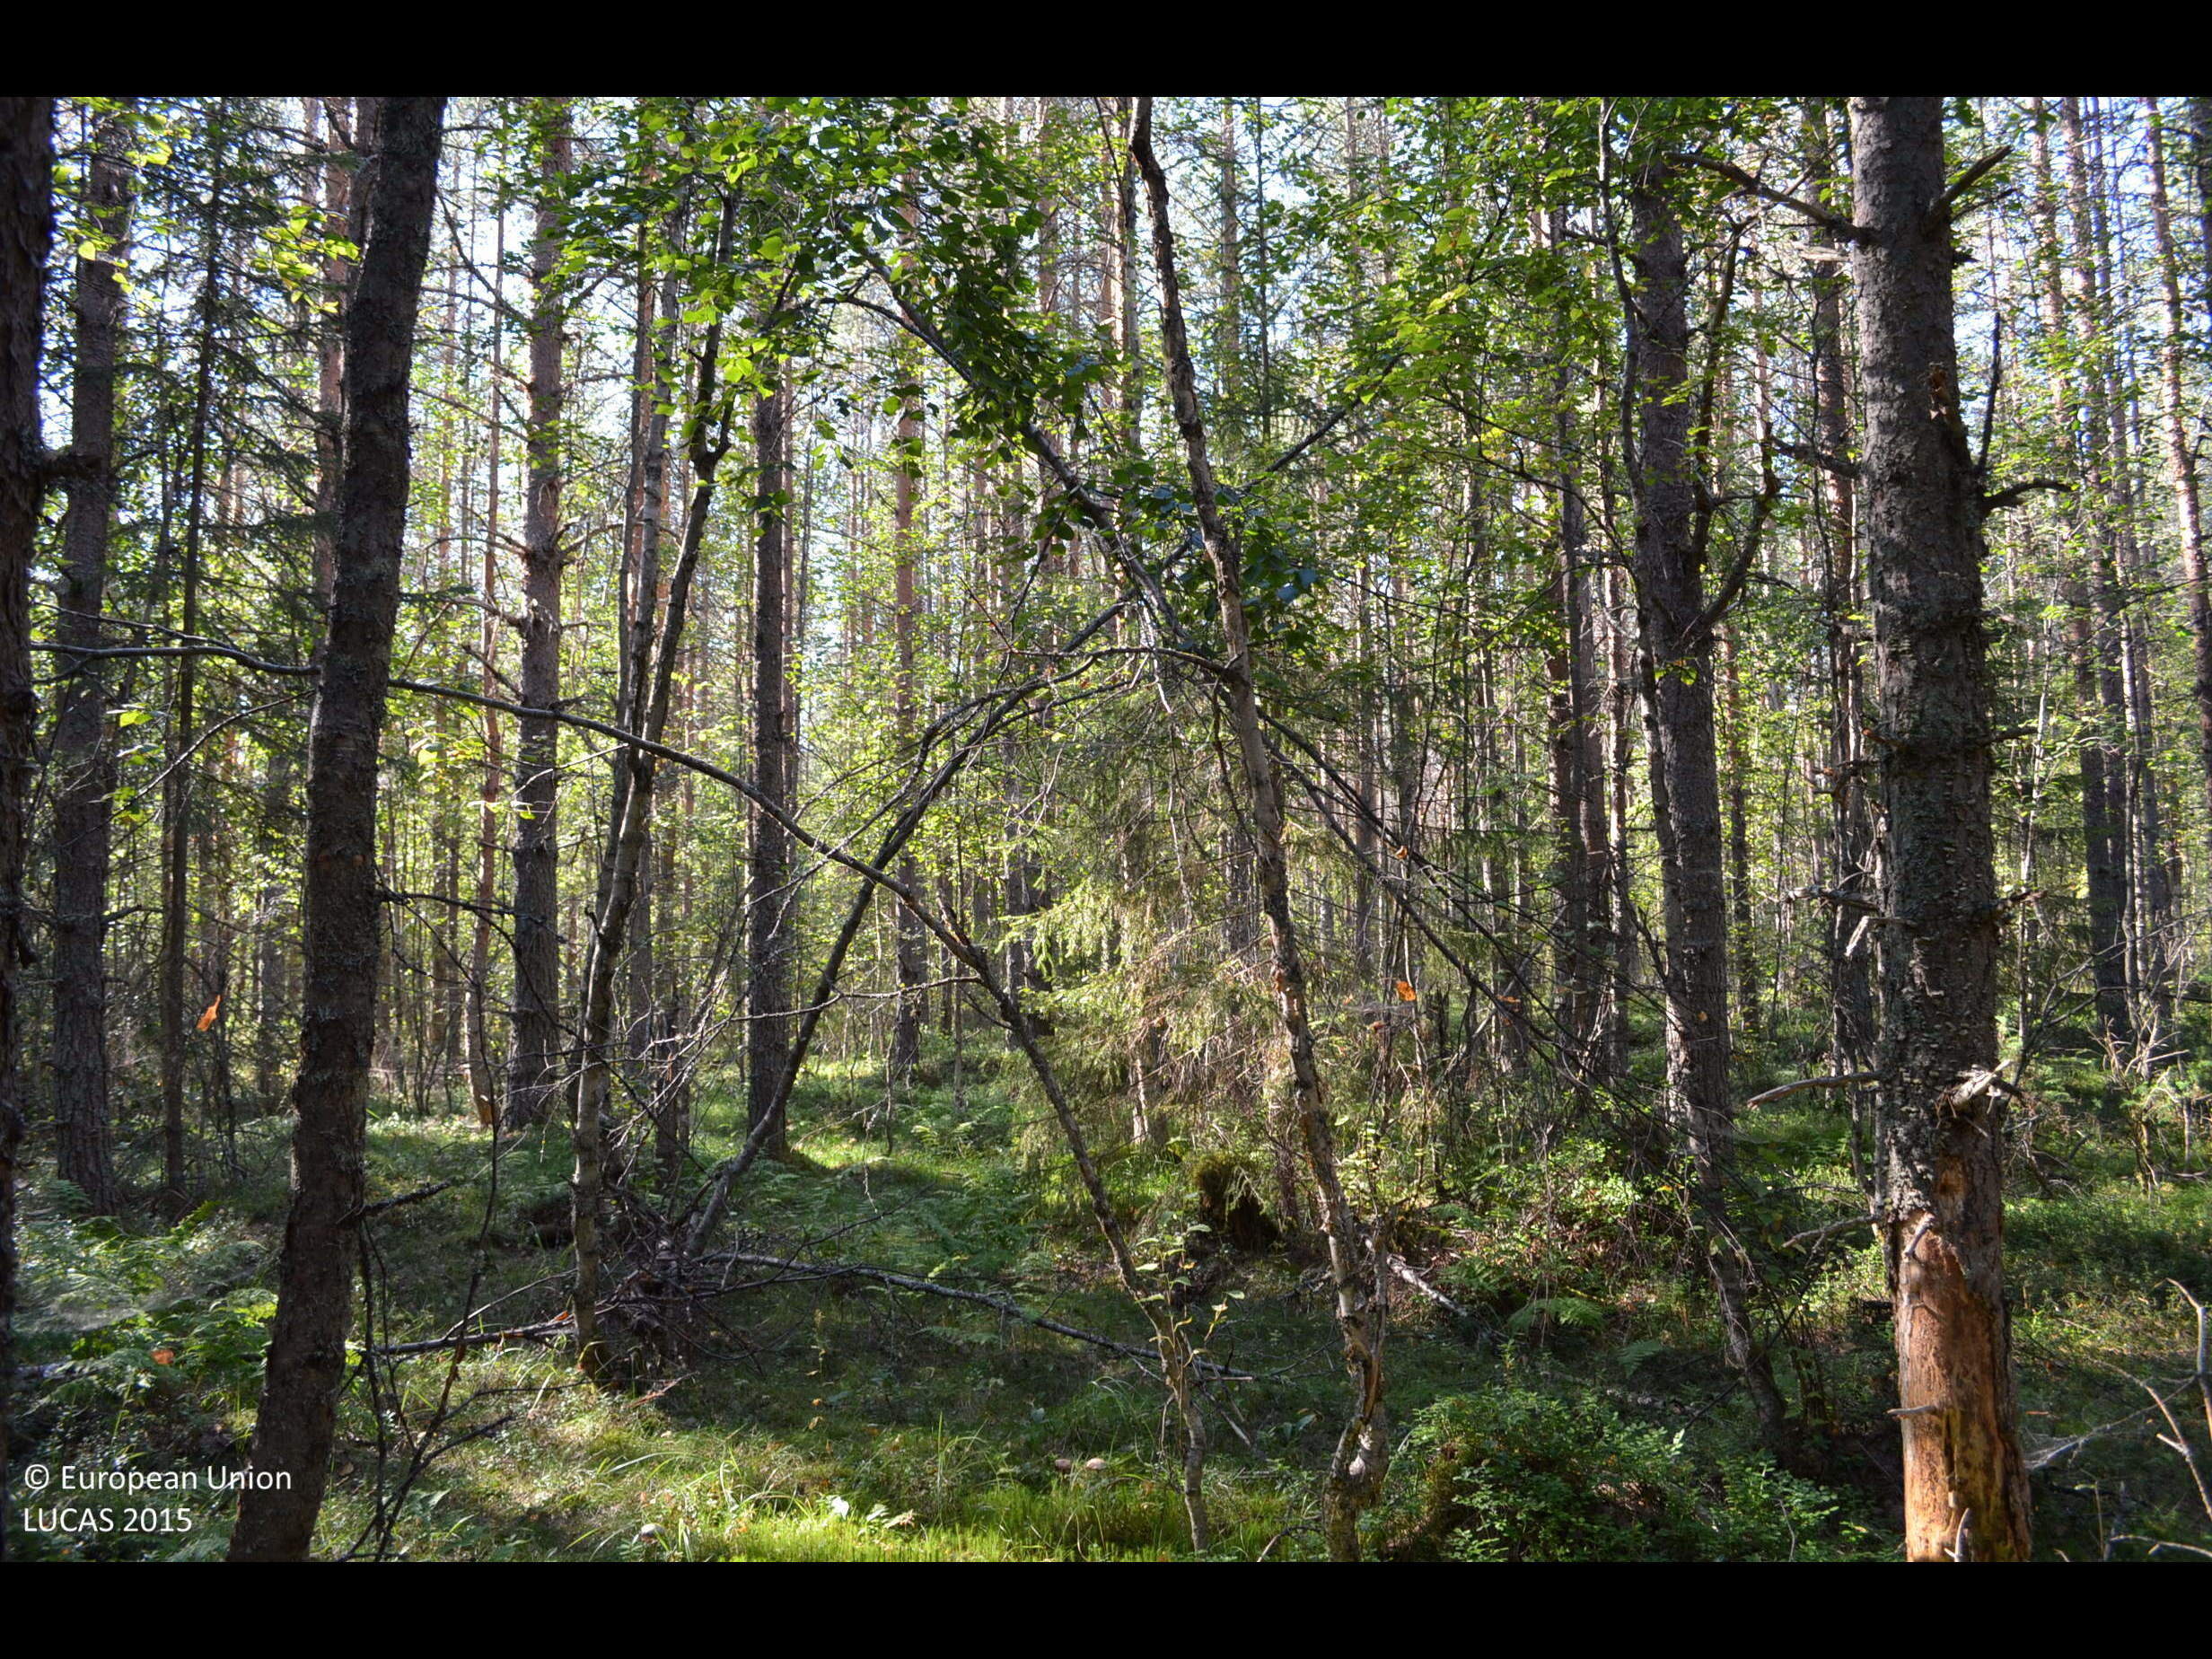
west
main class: Woodland
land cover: Pine dominated mixed woodland
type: boreal forest
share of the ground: > 75 %
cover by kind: coniferous forest trees 60 %, broadleaved forest trees 25 %, shrubs 5 %, lichens and mosses 5 %
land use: Forestry
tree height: > 5 m
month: August
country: FI
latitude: 62.4723
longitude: 24.3418
